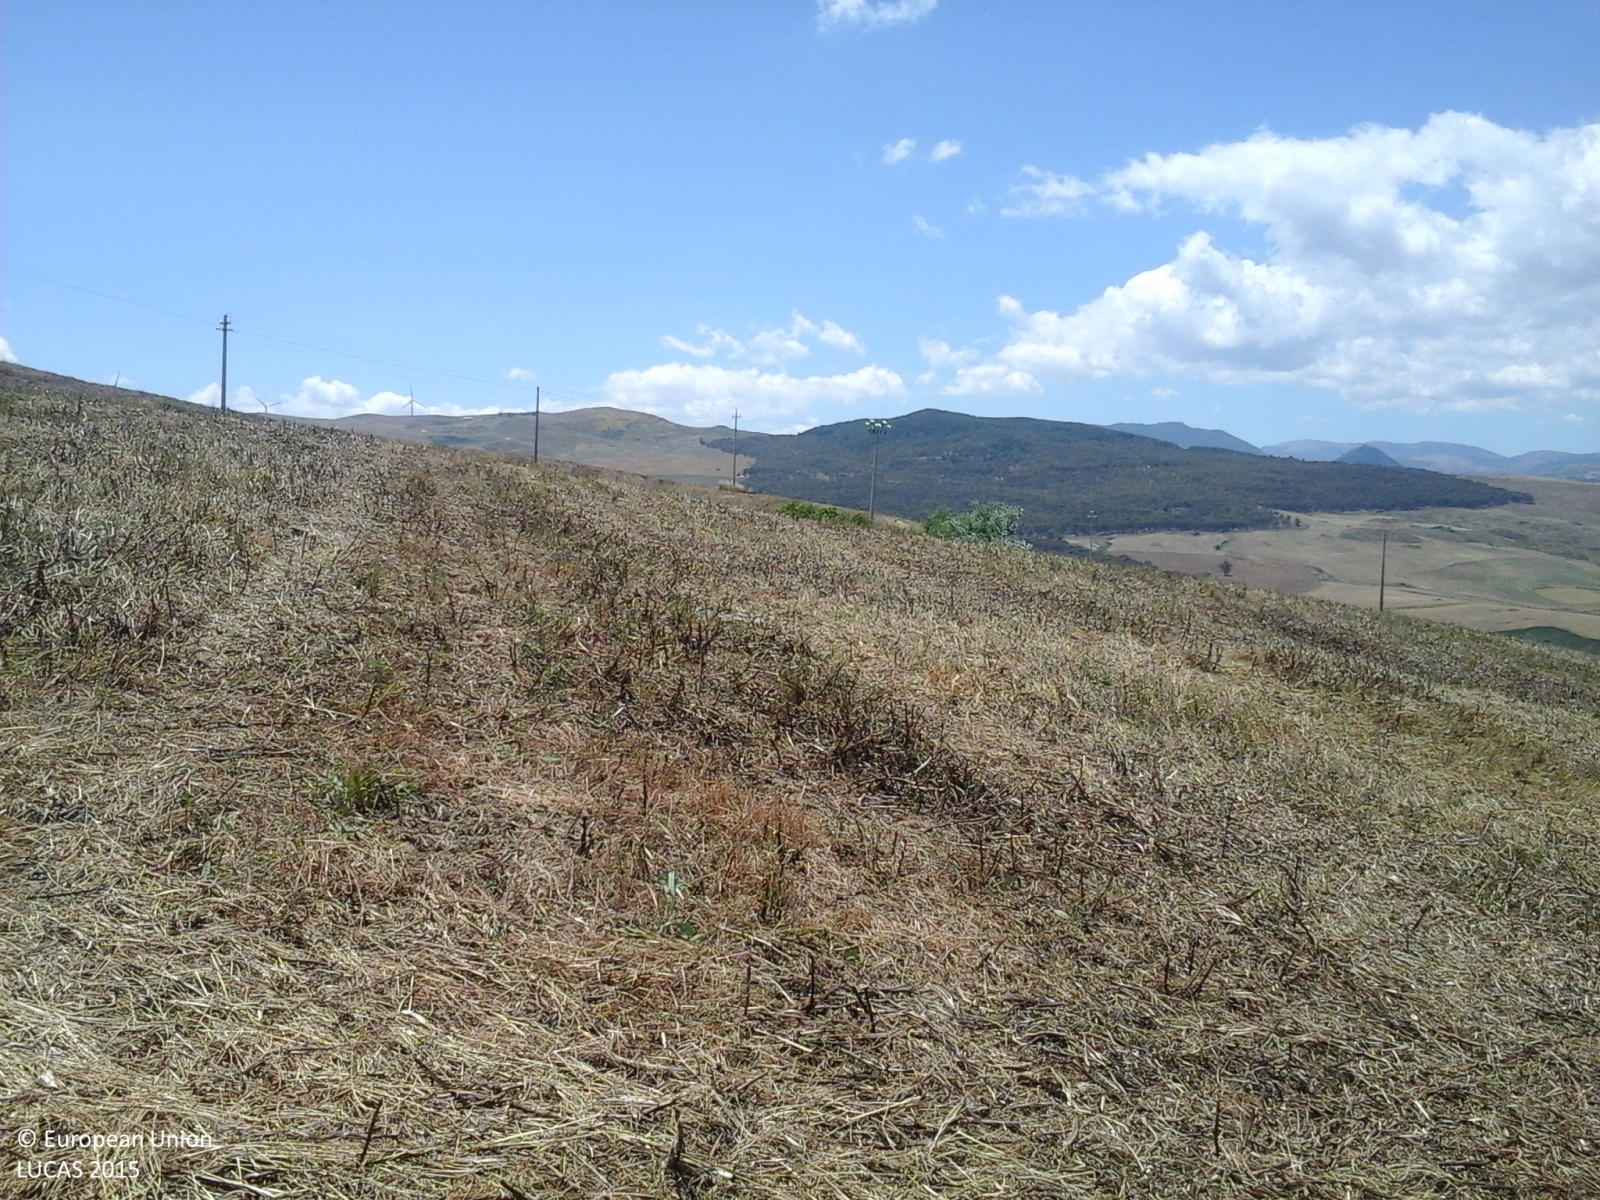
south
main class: Cropland
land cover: Dry pulses
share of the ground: > 75 %
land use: Agriculture (excluding fallow land and kitchen gardens)
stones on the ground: < 10 %
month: June
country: IT
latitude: 37.7894
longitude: 13.5737
